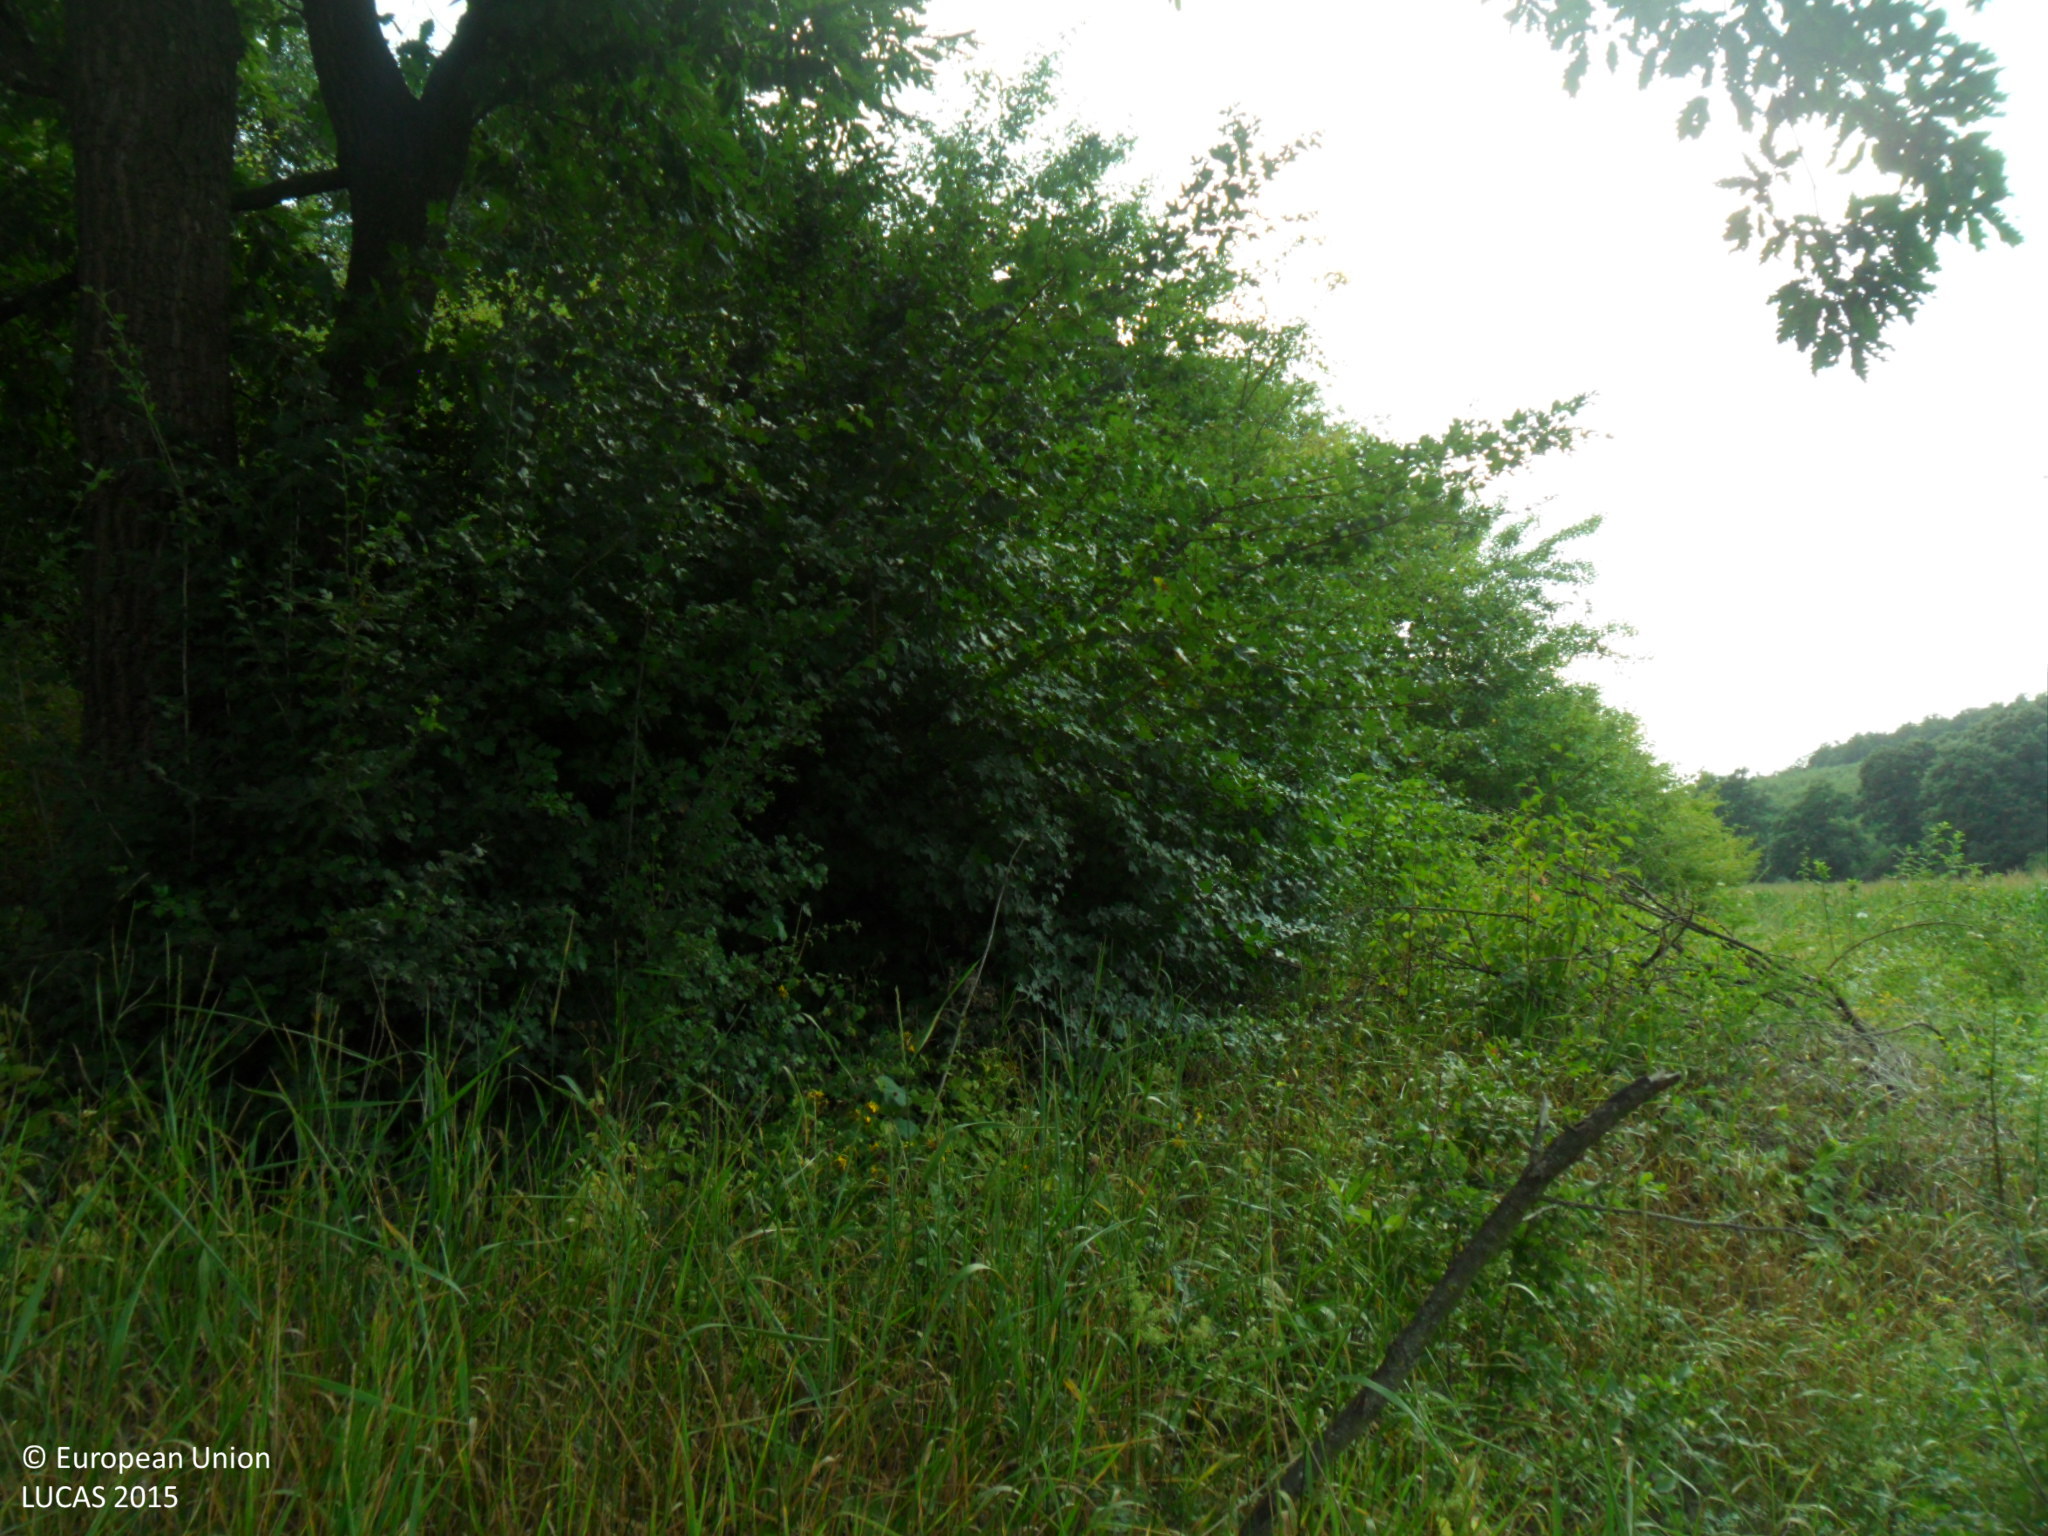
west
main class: Shrubland
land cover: Shrubland with sparse tree cover
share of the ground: > 75 %
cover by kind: shrubs 95 %, broadleaved forest trees 5 %
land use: Semi-natural and natural areas not in use
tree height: > 5 m
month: July
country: BG
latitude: 43.5821
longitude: 27.2017
